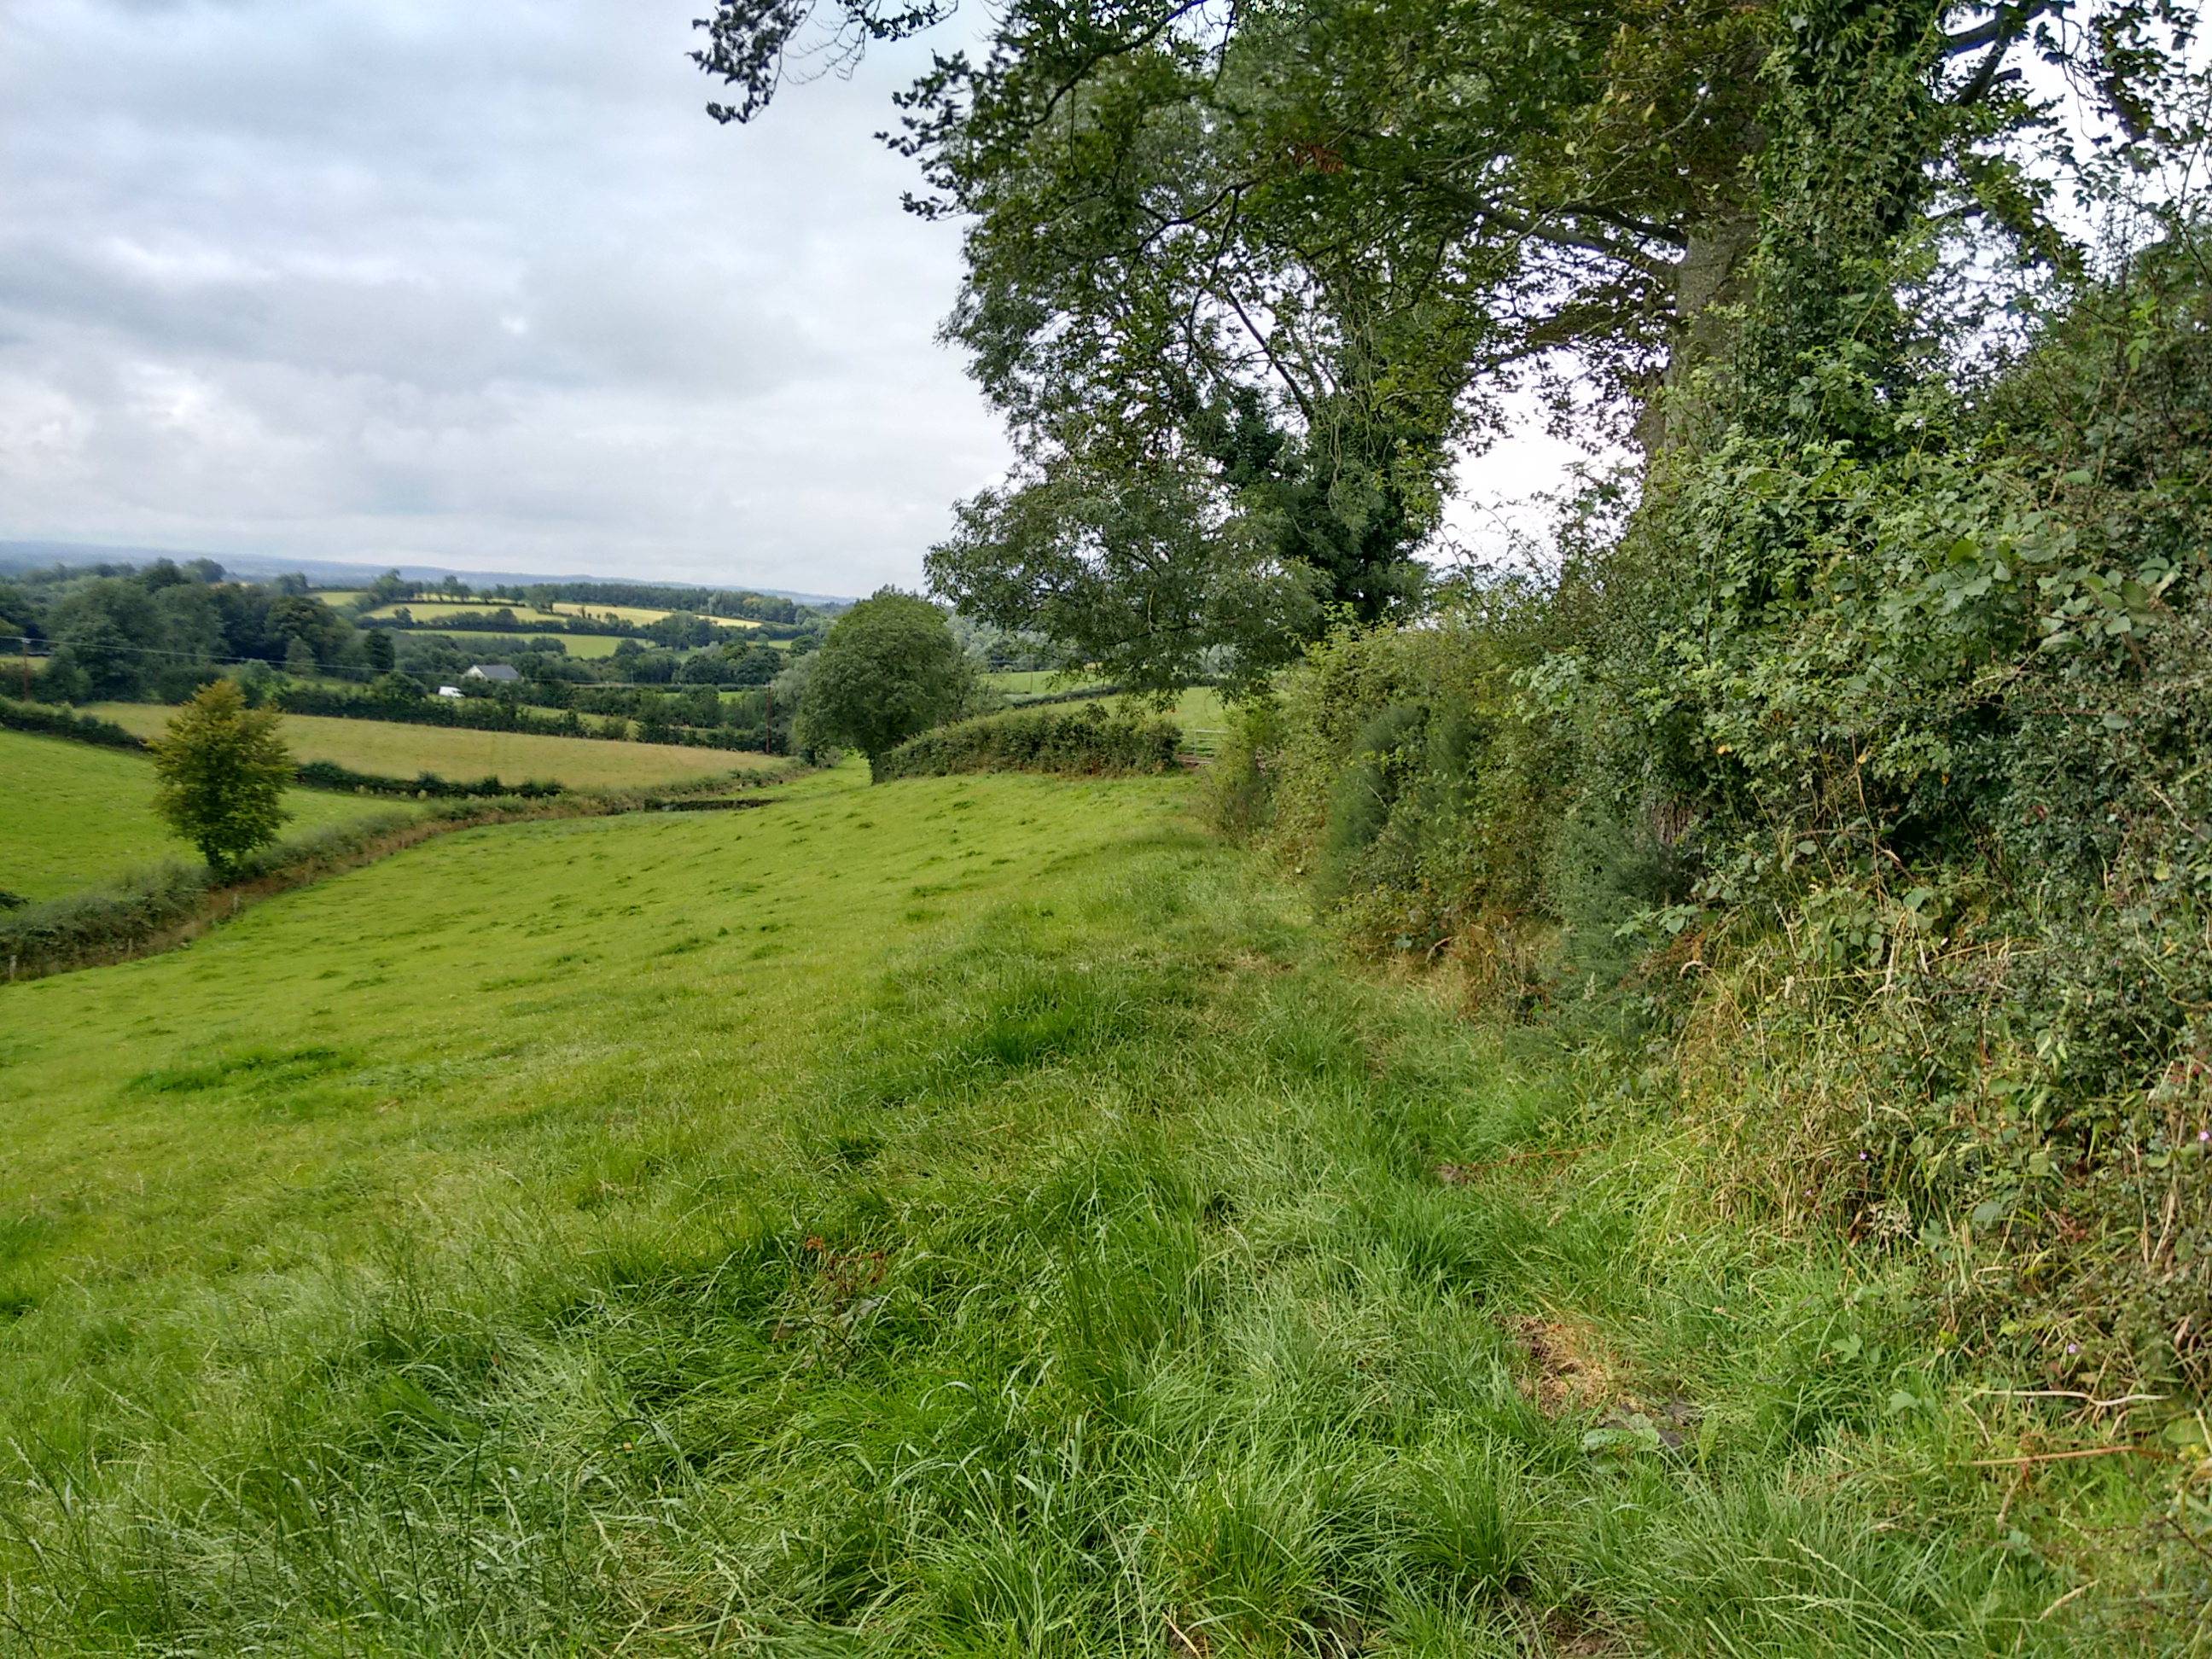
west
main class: Grassland
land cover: Grassland without tree/shrub cover
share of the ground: > 75 %
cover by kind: herbaceous plants 100 %
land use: Agriculture (excluding fallow land and kitchen gardens)
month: August
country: GB
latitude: 54.3901
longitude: -6.9077
